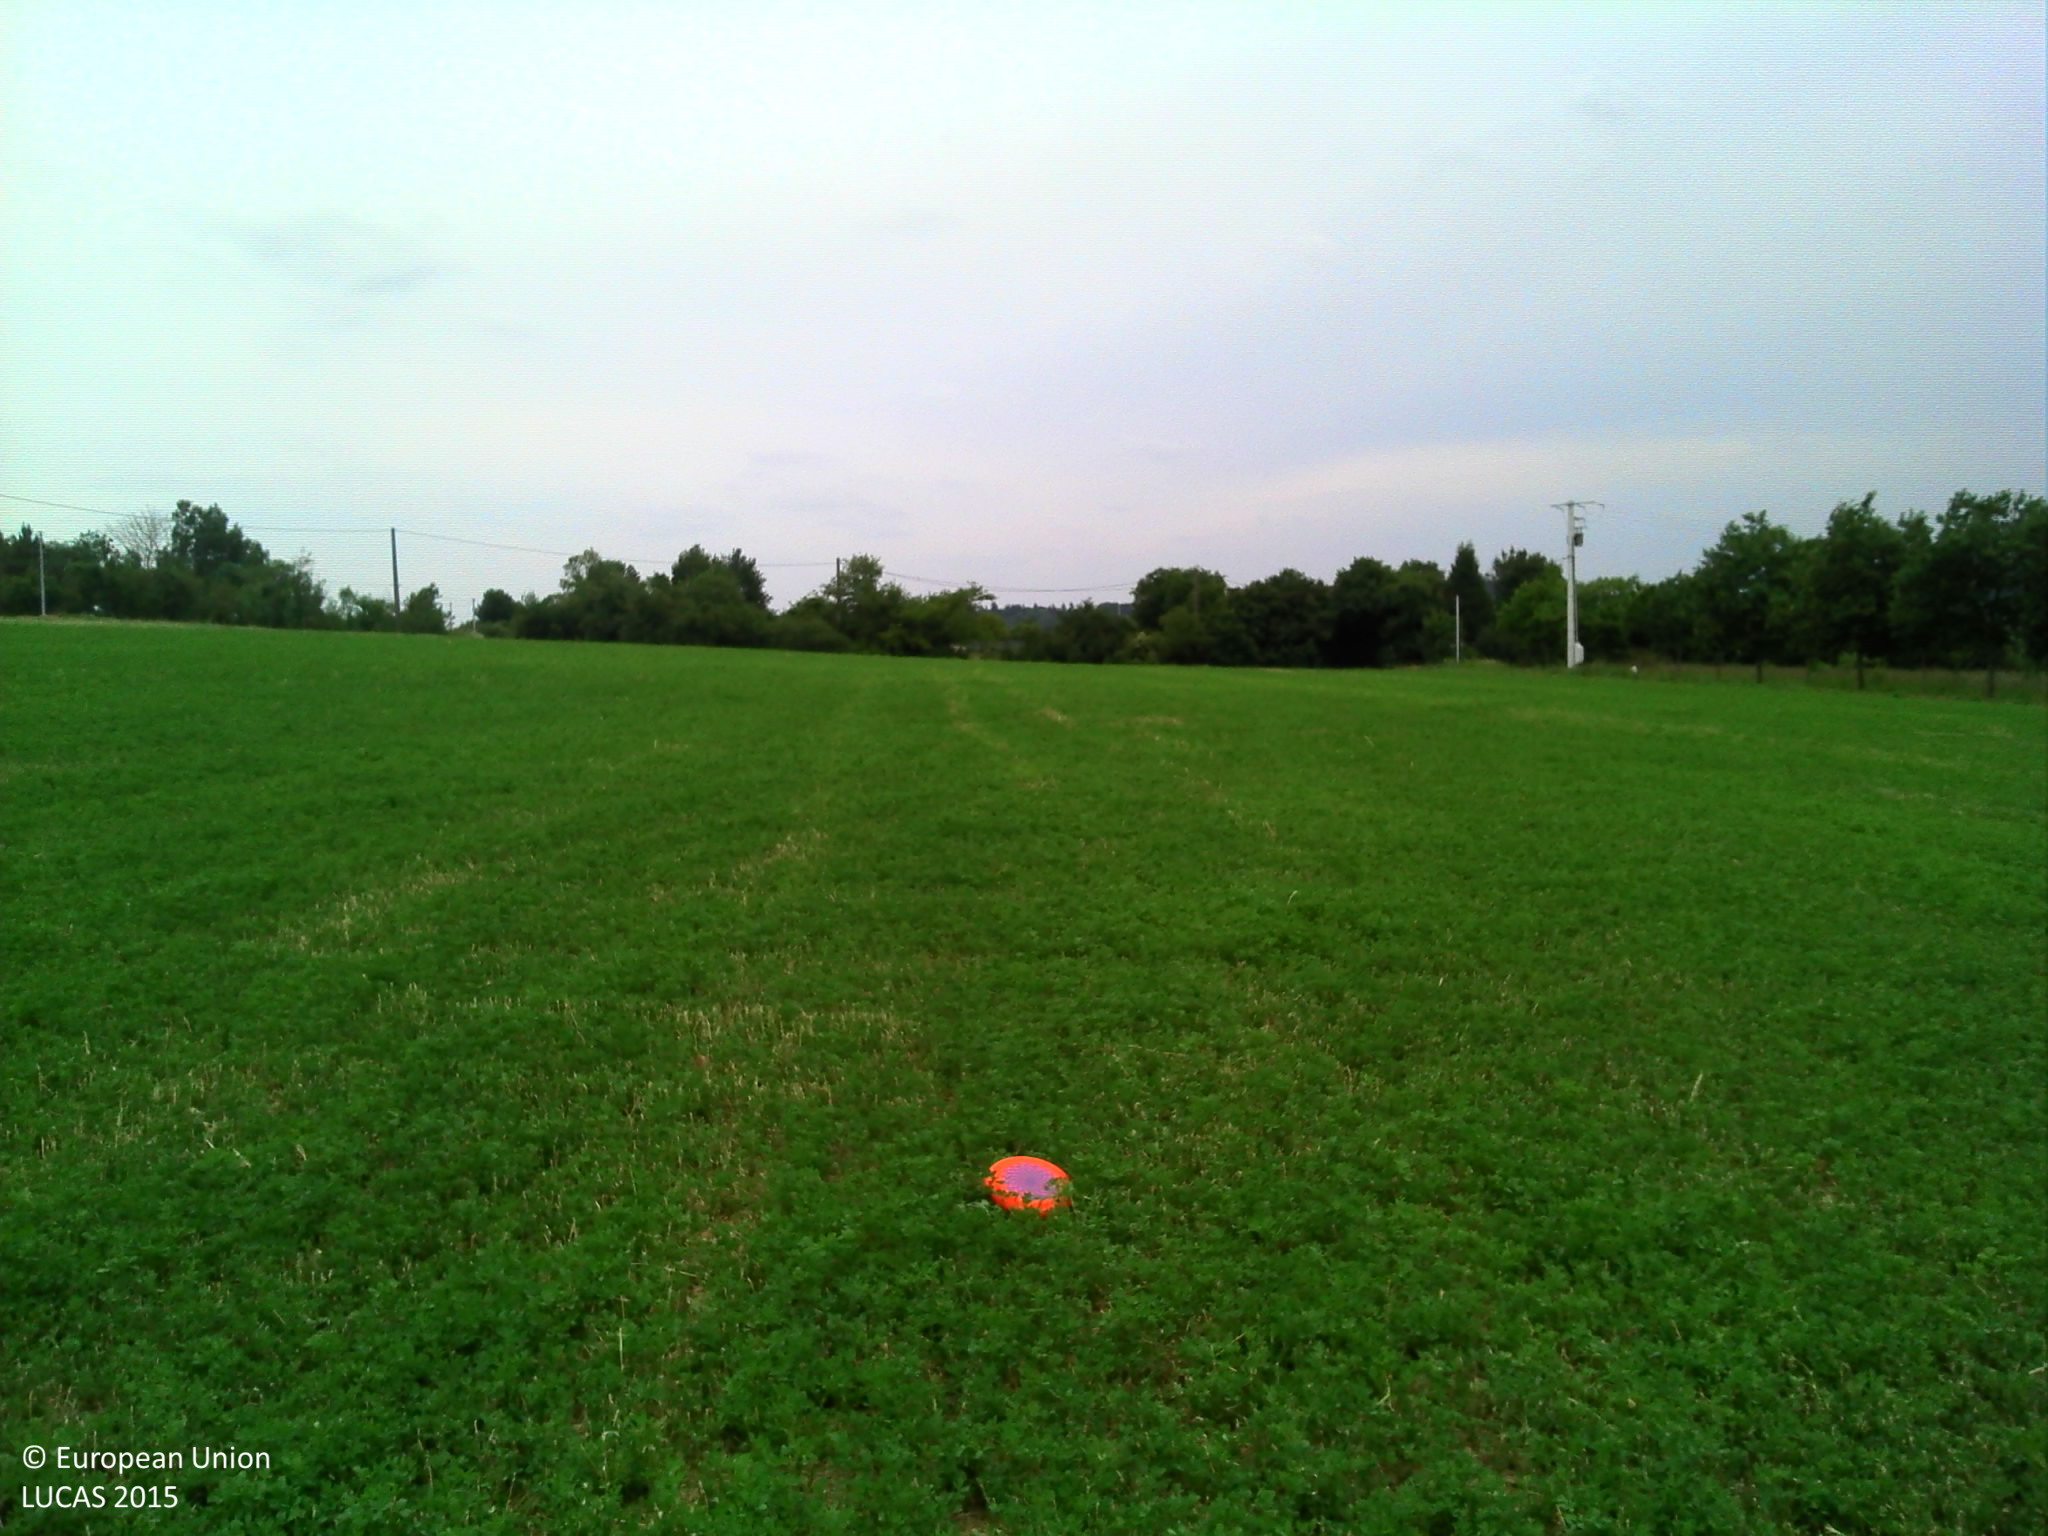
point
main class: Cropland
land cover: Other leguminous and mixtures for fodder
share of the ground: > 75 %
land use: Agriculture (excluding fallow land and kitchen gardens)
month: June
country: FR
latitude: 48.2361
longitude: -0.0329
